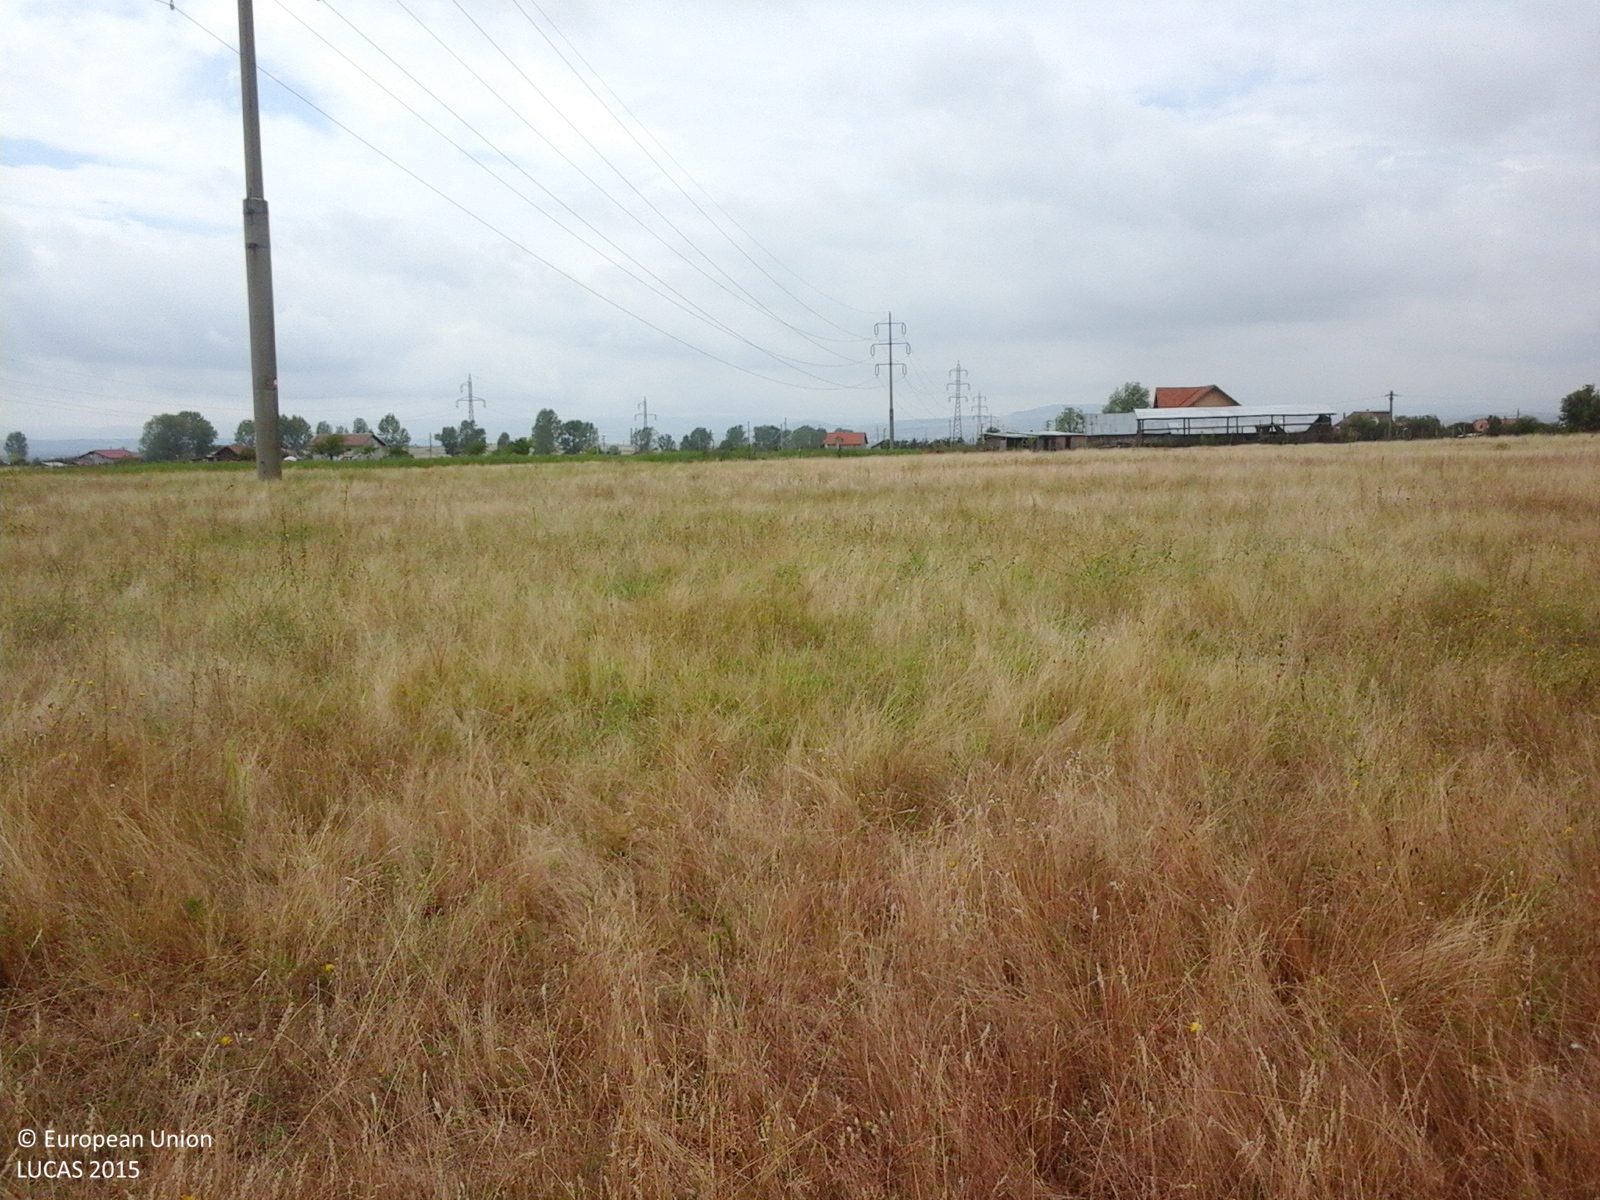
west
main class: Grassland
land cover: Grassland without tree/shrub cover
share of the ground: > 75 %
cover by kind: herbaceous plants 100 %
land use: Agriculture (excluding fallow land and kitchen gardens)
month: August
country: RO
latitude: 44.6204
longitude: 22.7337
